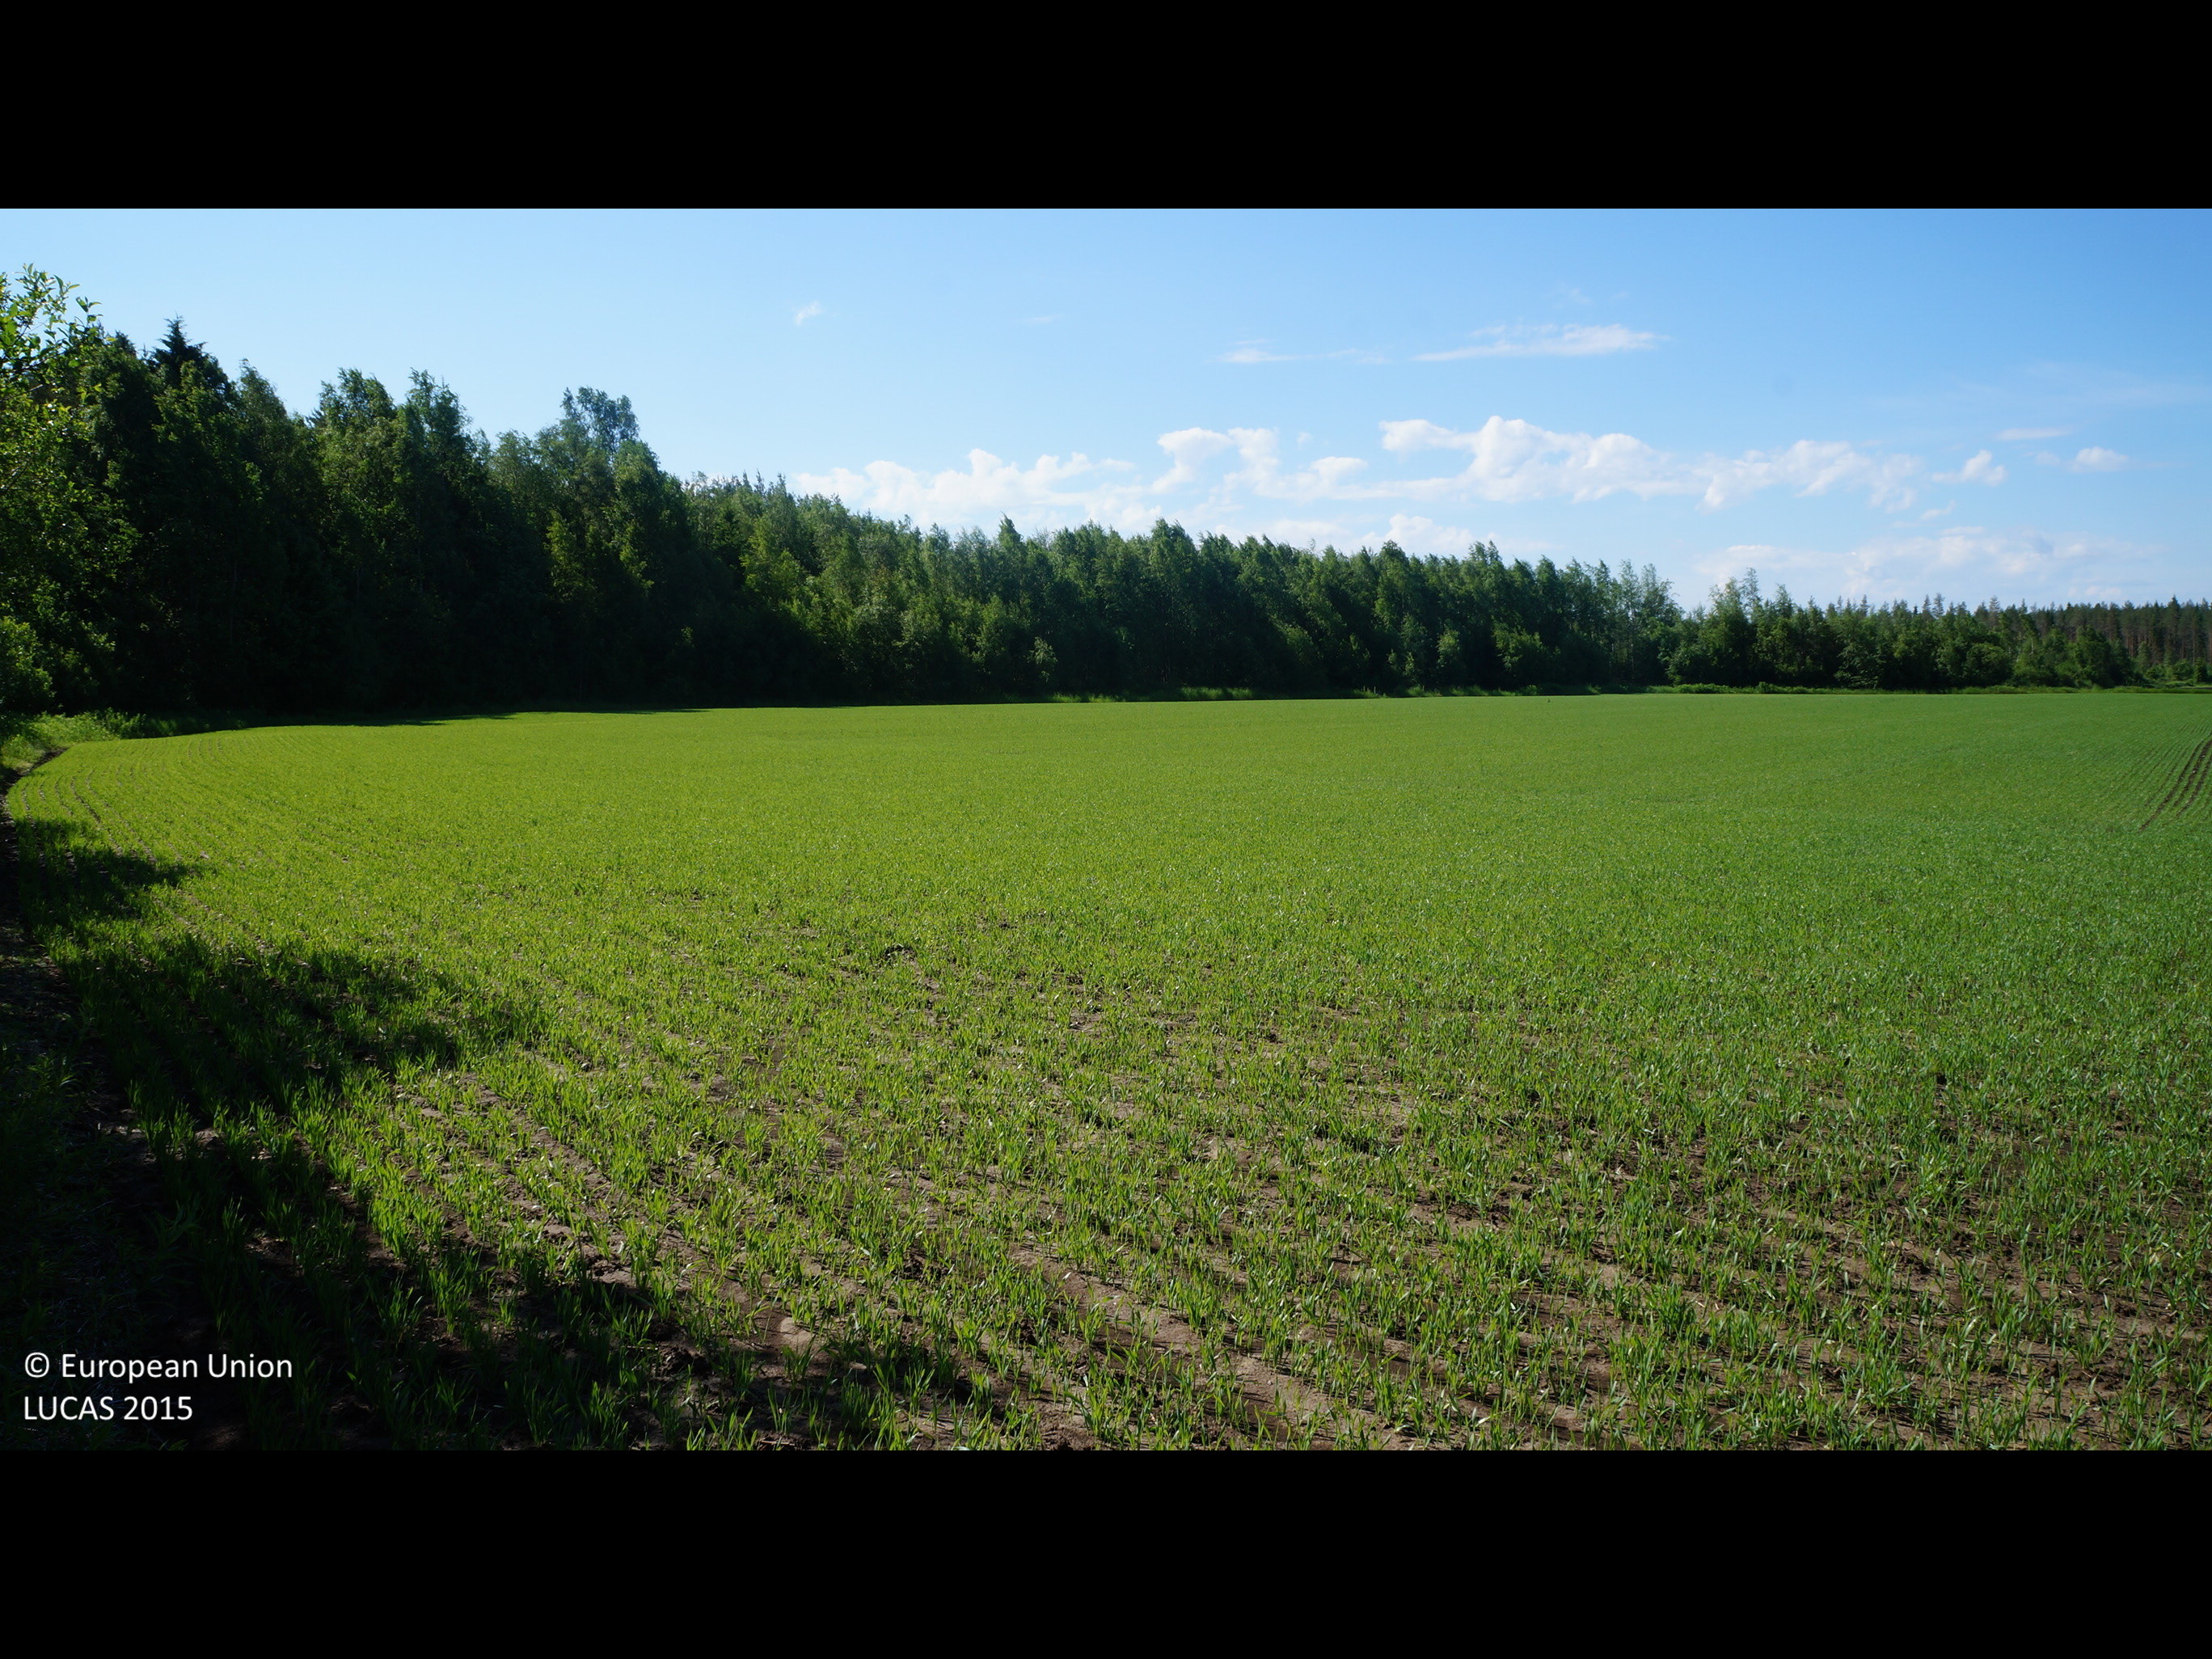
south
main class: Cropland
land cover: Barley
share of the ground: 25 - 50 %
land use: Agriculture (excluding fallow land and kitchen gardens)
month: June
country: FI
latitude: 64.1227
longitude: 23.7992
